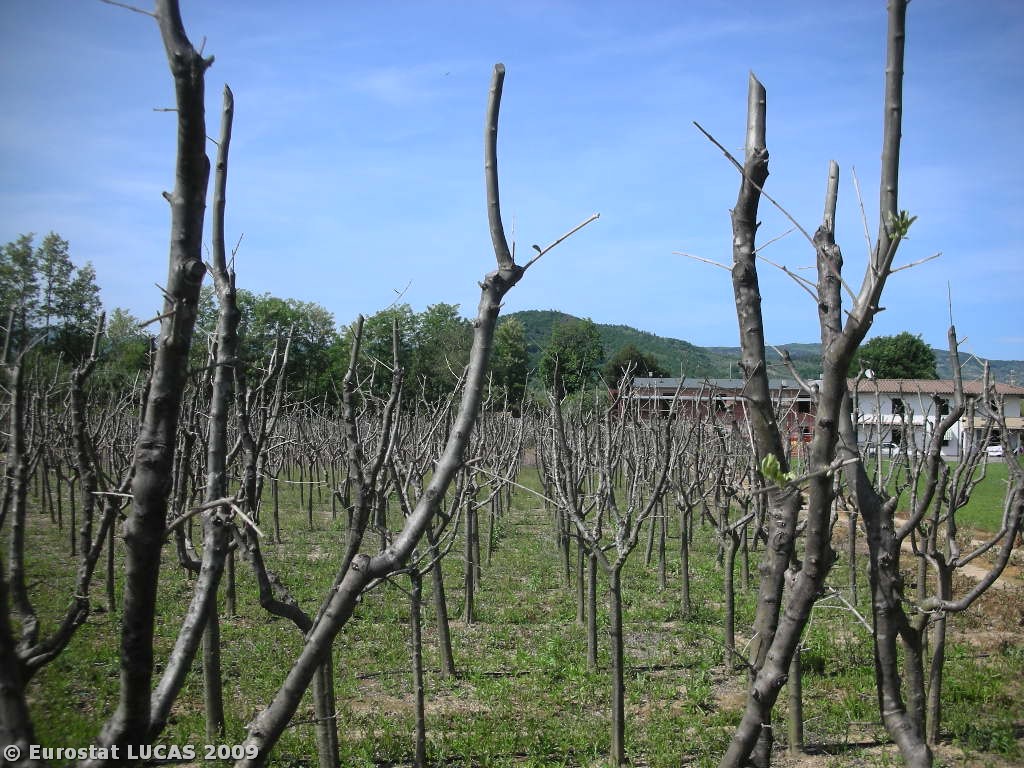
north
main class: Cropland
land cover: Nurseries
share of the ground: 50 - 75 %
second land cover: Grassland with sparse tree/shrub cover
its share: > 75 %
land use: Agriculture (excluding fallow land and kitchen gardens)
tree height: < 5 m
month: May
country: IT
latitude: 43.8784
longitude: 10.8069
